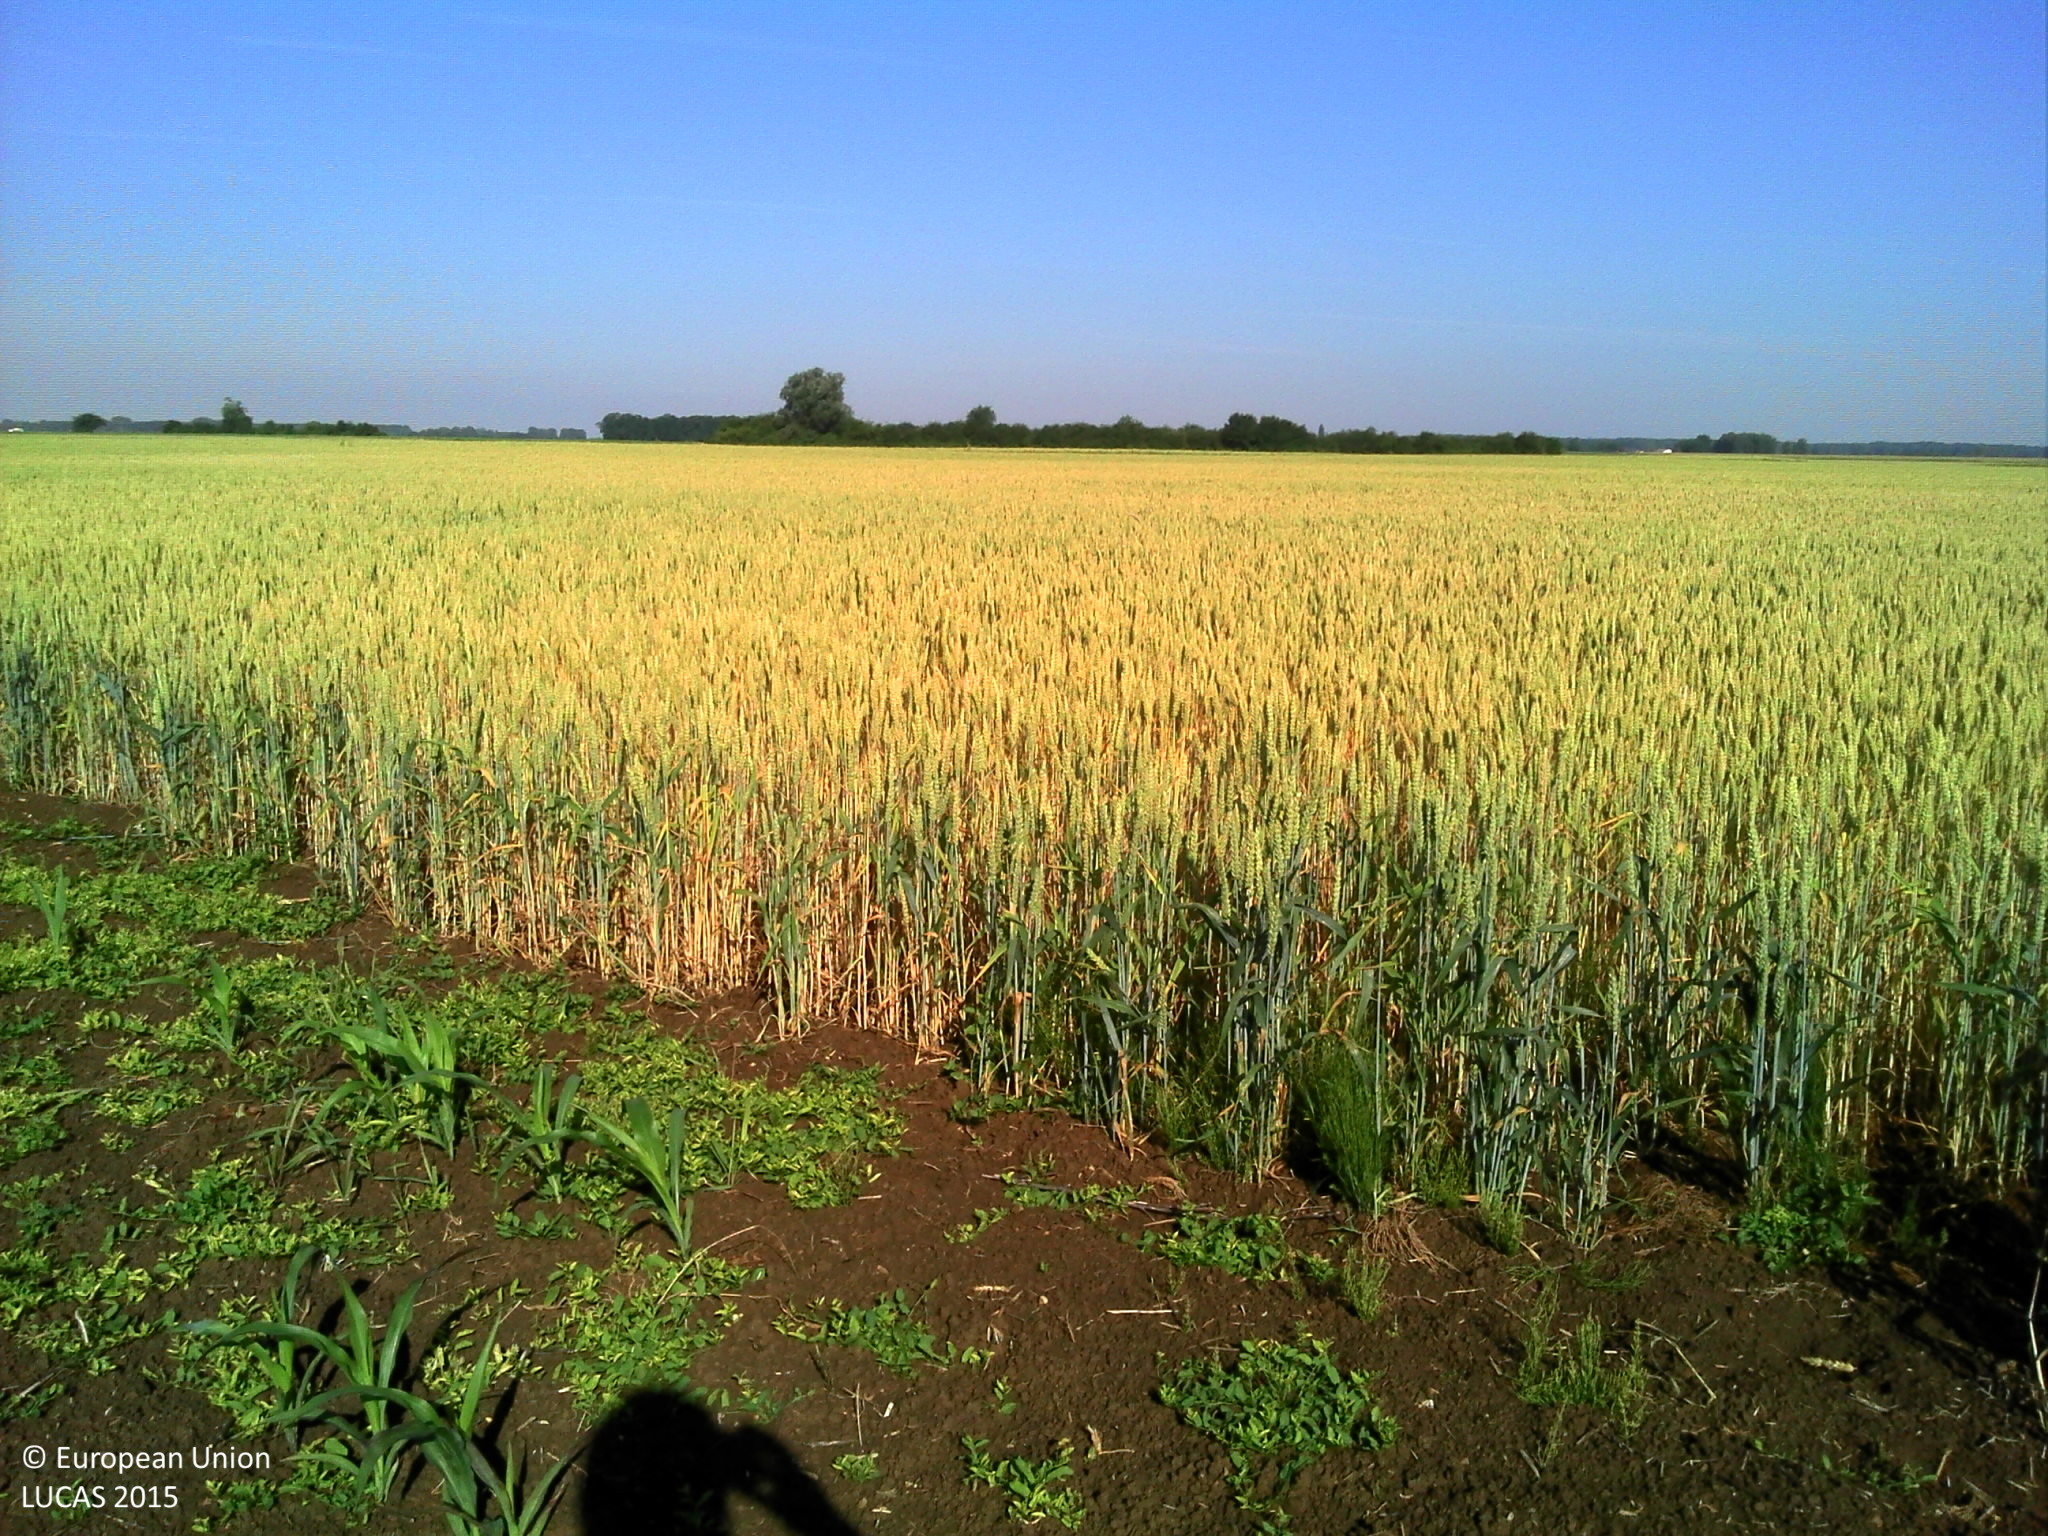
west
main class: Cropland
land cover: Maize
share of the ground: 25 - 50 %
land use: Agriculture (excluding fallow land and kitchen gardens)
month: June
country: FR
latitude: 46.9519
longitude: 5.3108
